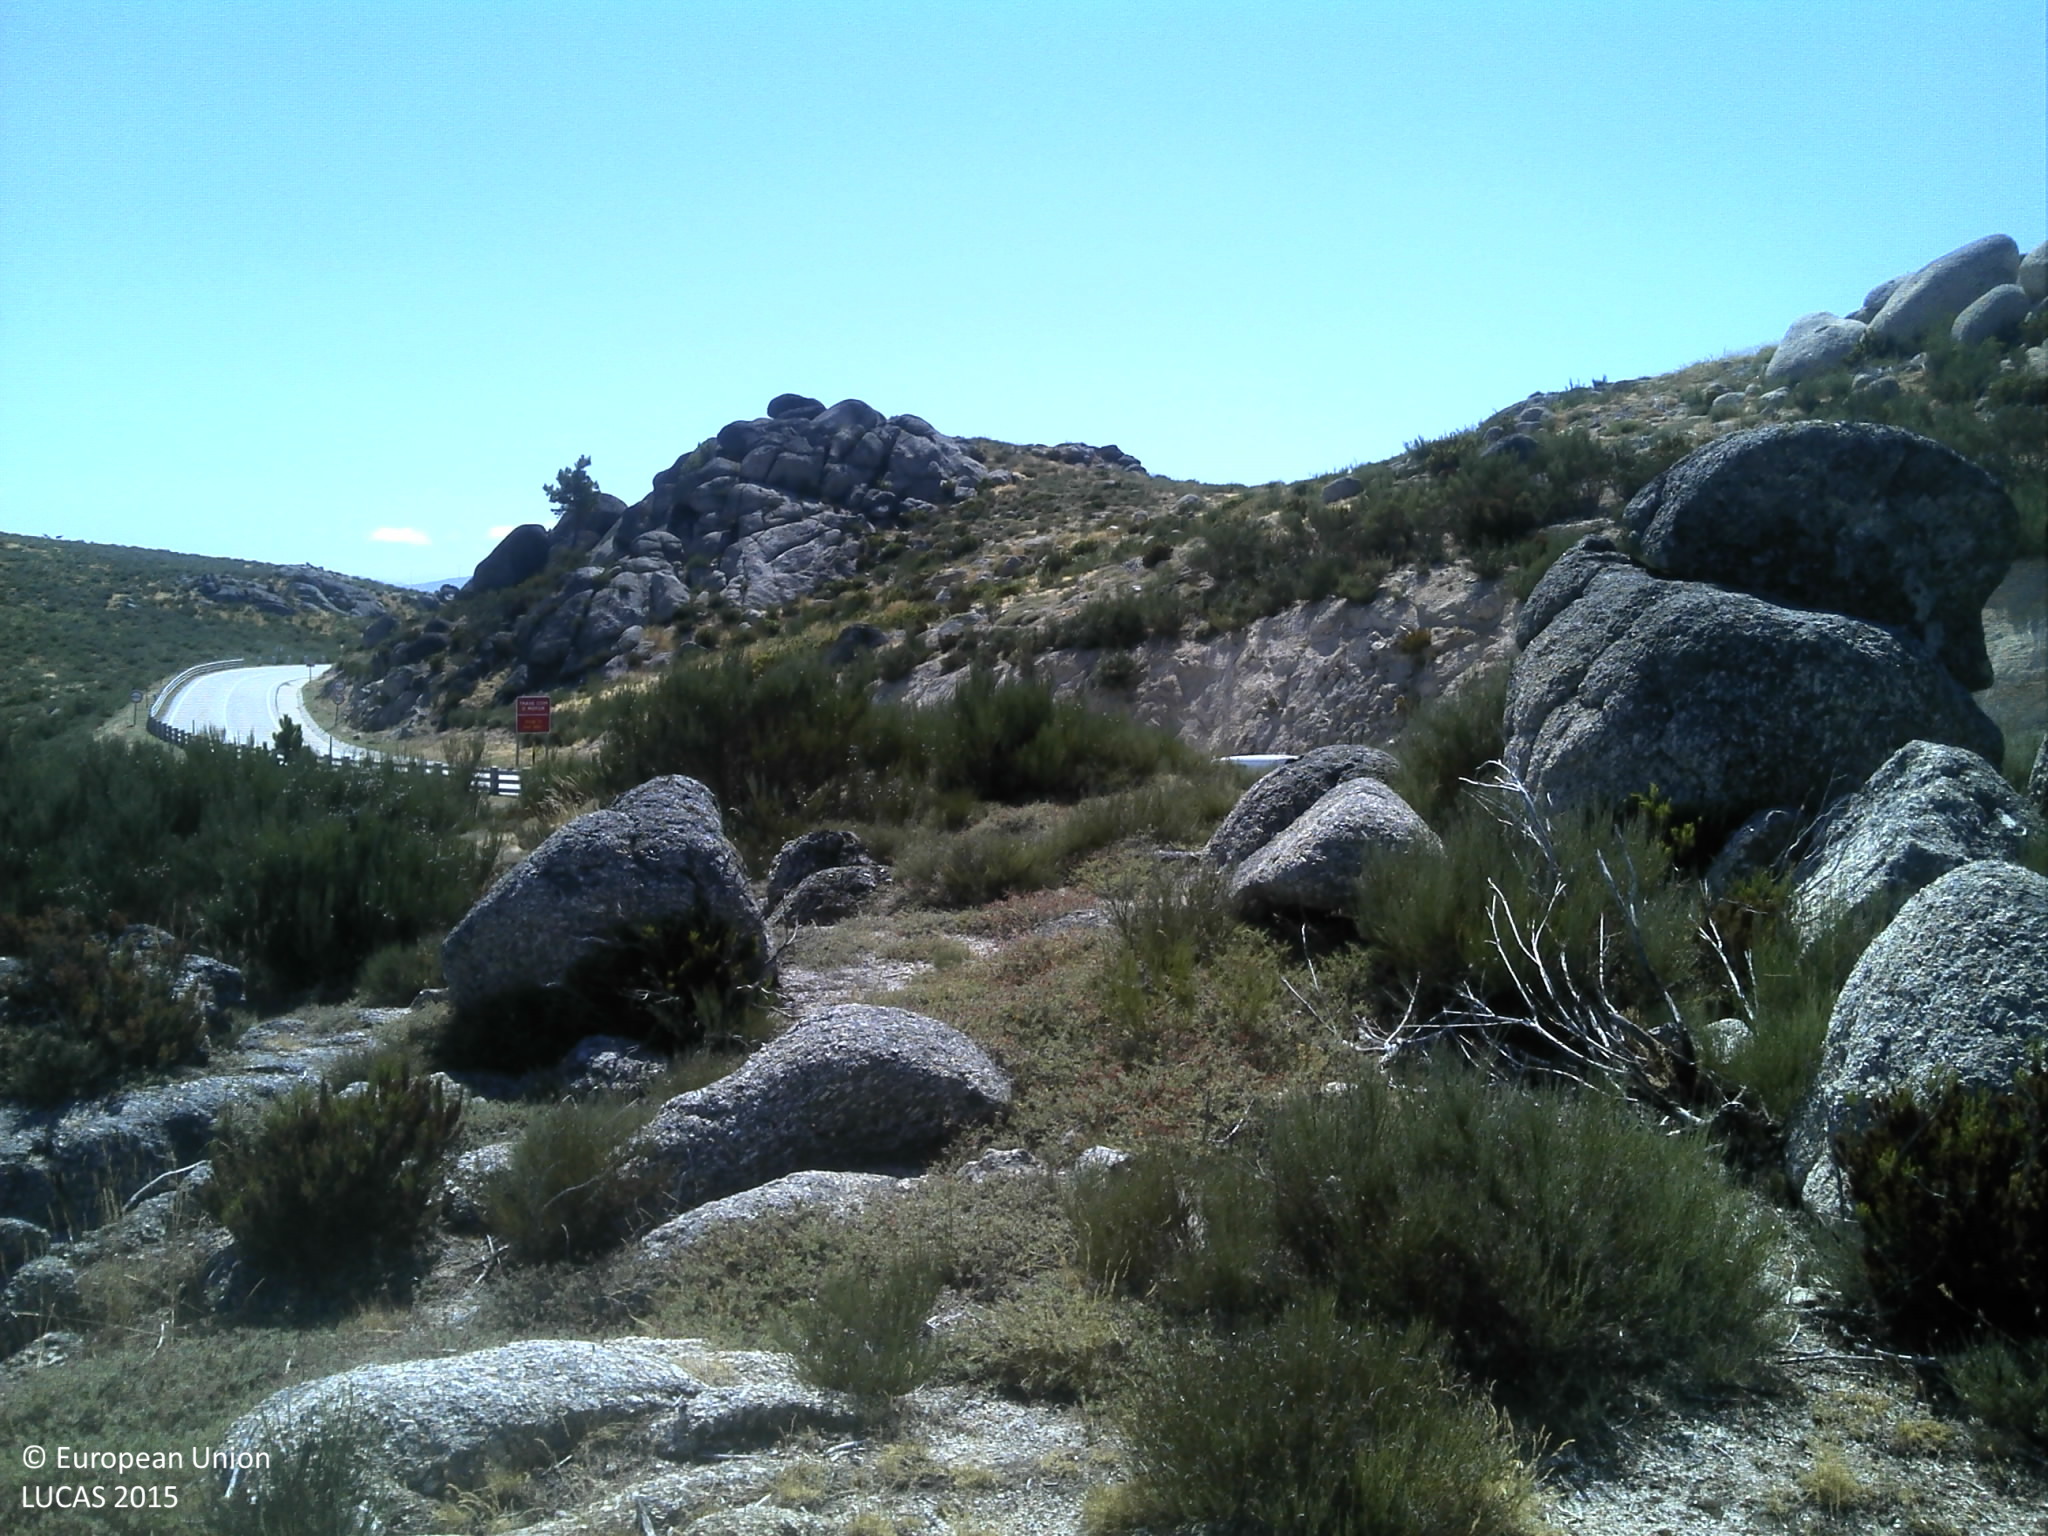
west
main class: Shrubland
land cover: Shrubland without tree cover
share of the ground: 50 - 75 %
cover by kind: shrubs 60 %, unconsolidated bare surface 30 %, herbaceous plants 10 %
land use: Semi-natural and natural areas not in use
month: July
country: PT
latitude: 40.3442
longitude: -7.6896
